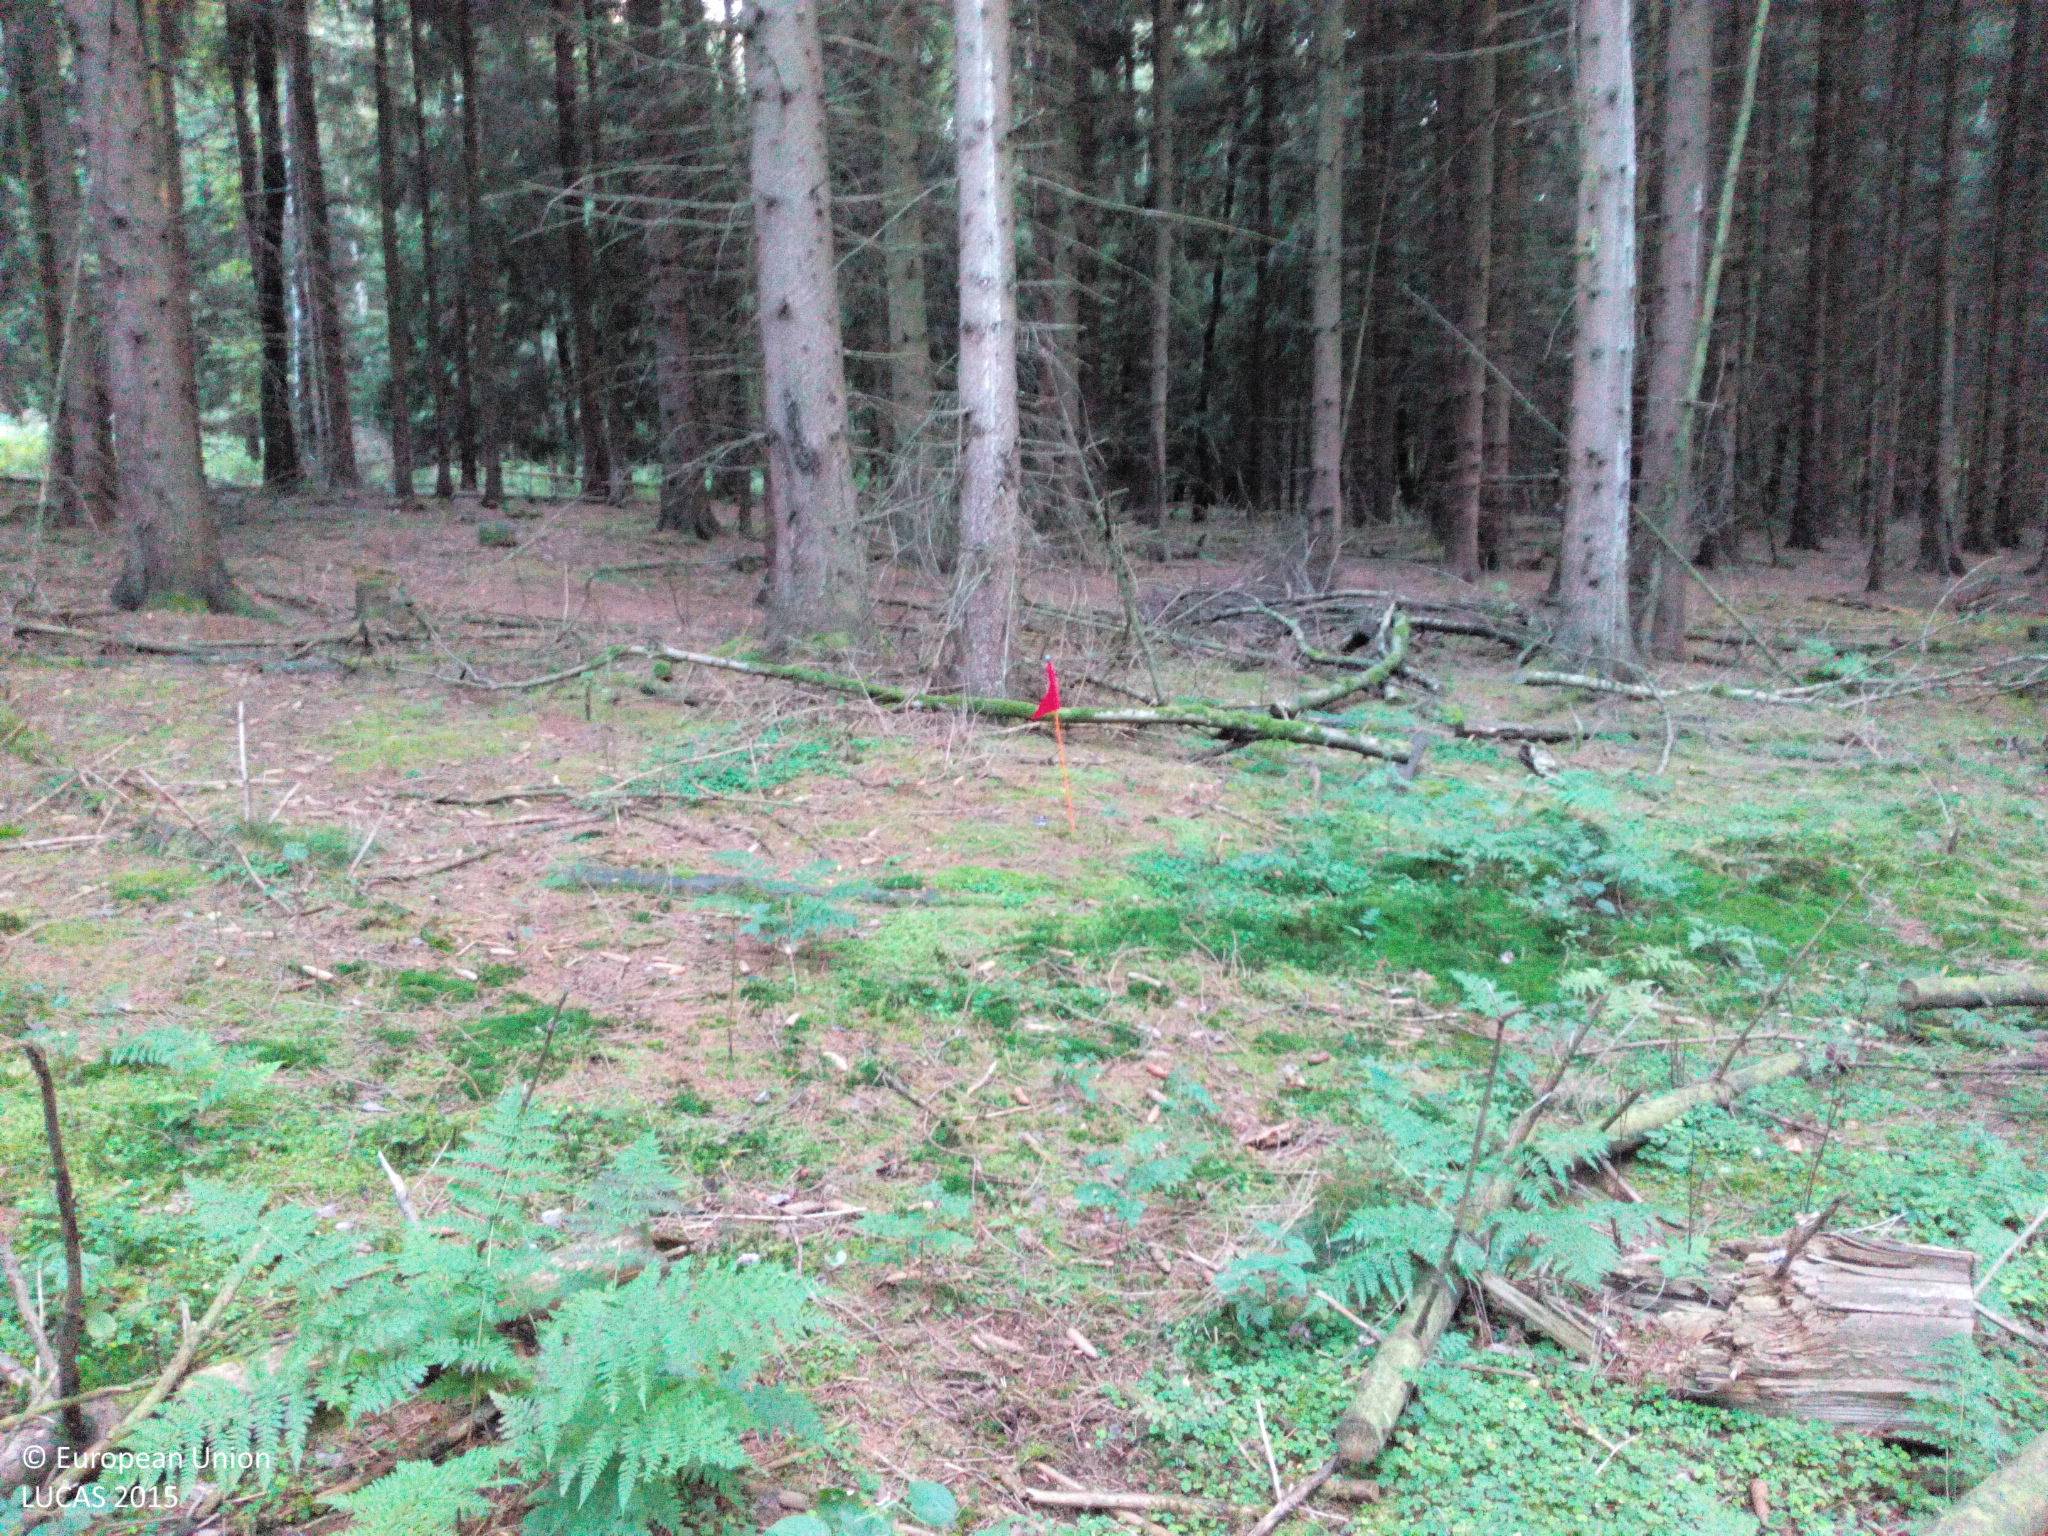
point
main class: Woodland
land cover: Spruce dominated coniferous woodland
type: hemiboreal forest and nemoral coniferous forest and mixed broadleaved-coniferous forest
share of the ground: > 75 %
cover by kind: coniferous forest trees 100 %
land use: Forestry
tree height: > 5 m
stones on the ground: < 10 %
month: September
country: DE
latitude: 51.5274
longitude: 11.1096
